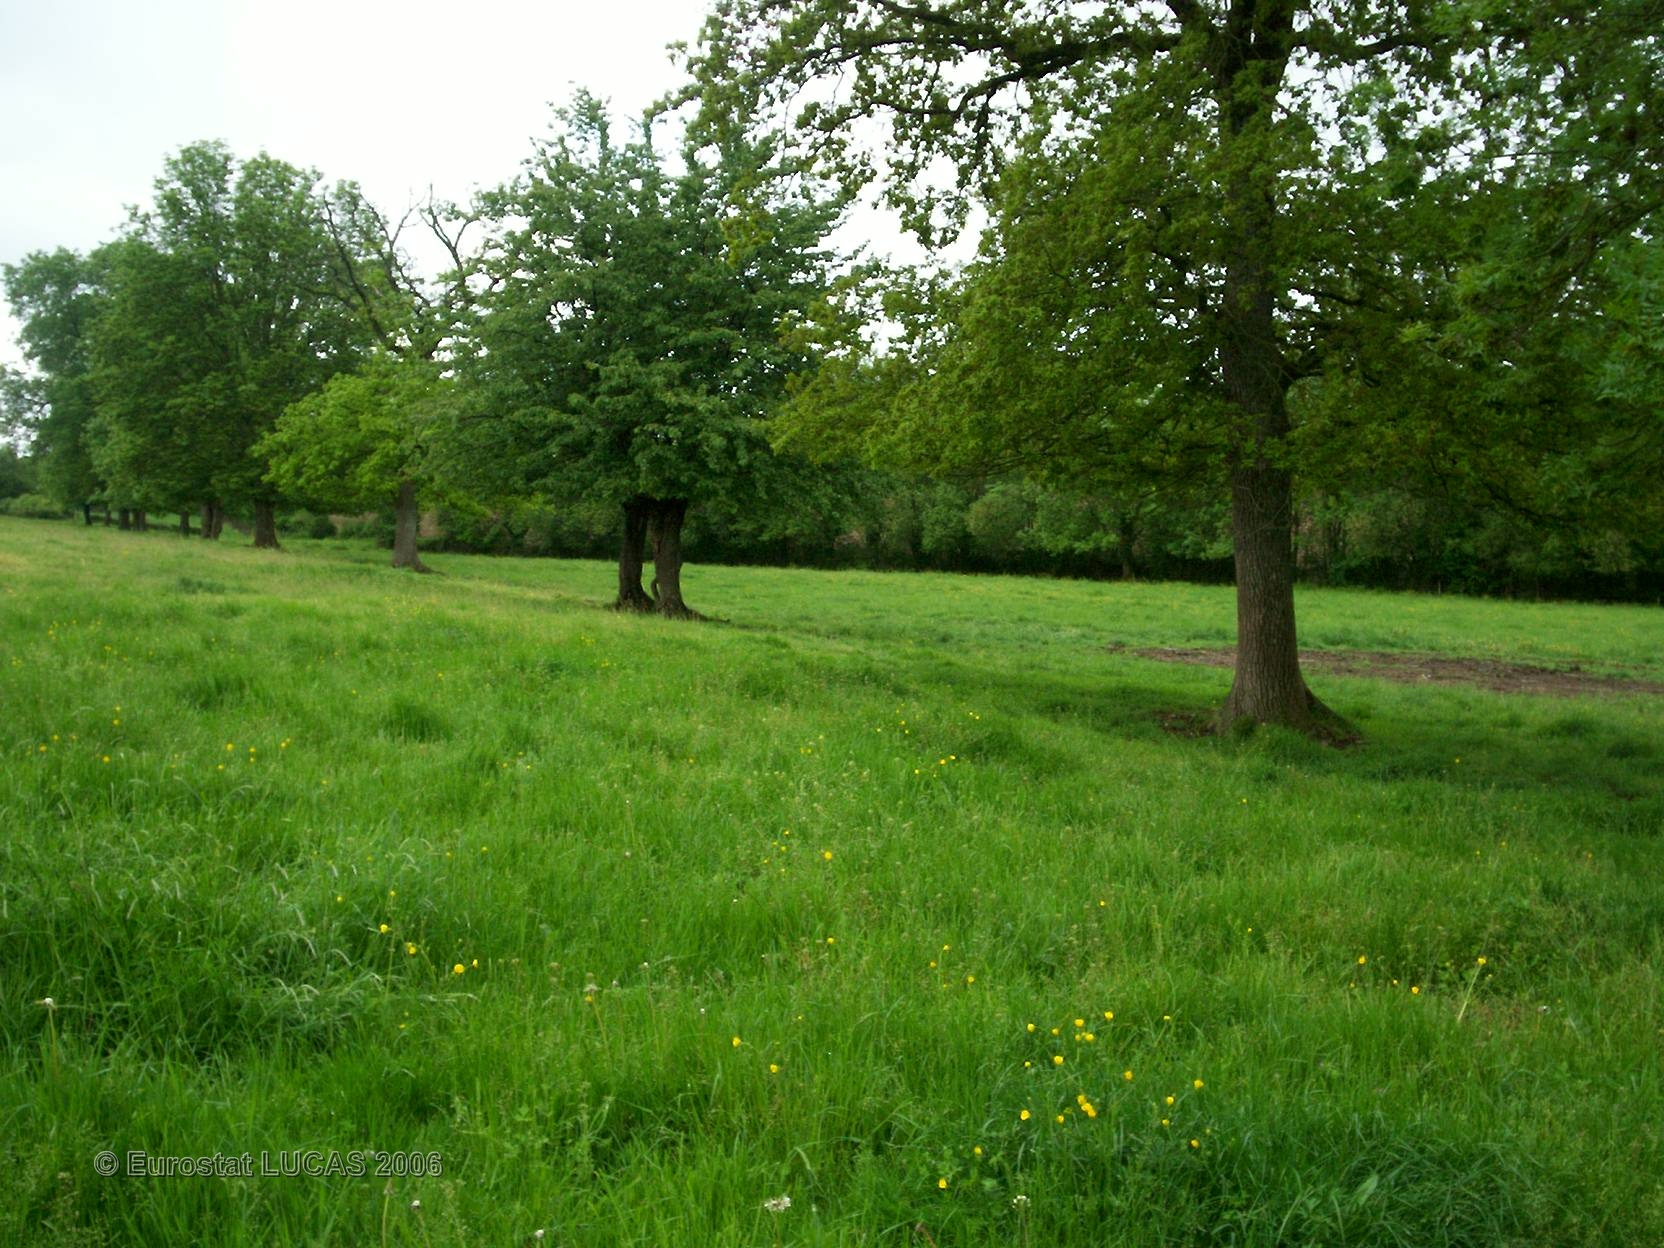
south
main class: Grassland
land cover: Grassland without tree/shrub cover
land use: Agriculture (excluding fallow land and kitchen gardens)
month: May
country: FR
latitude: 46.6885
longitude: -0.2895
